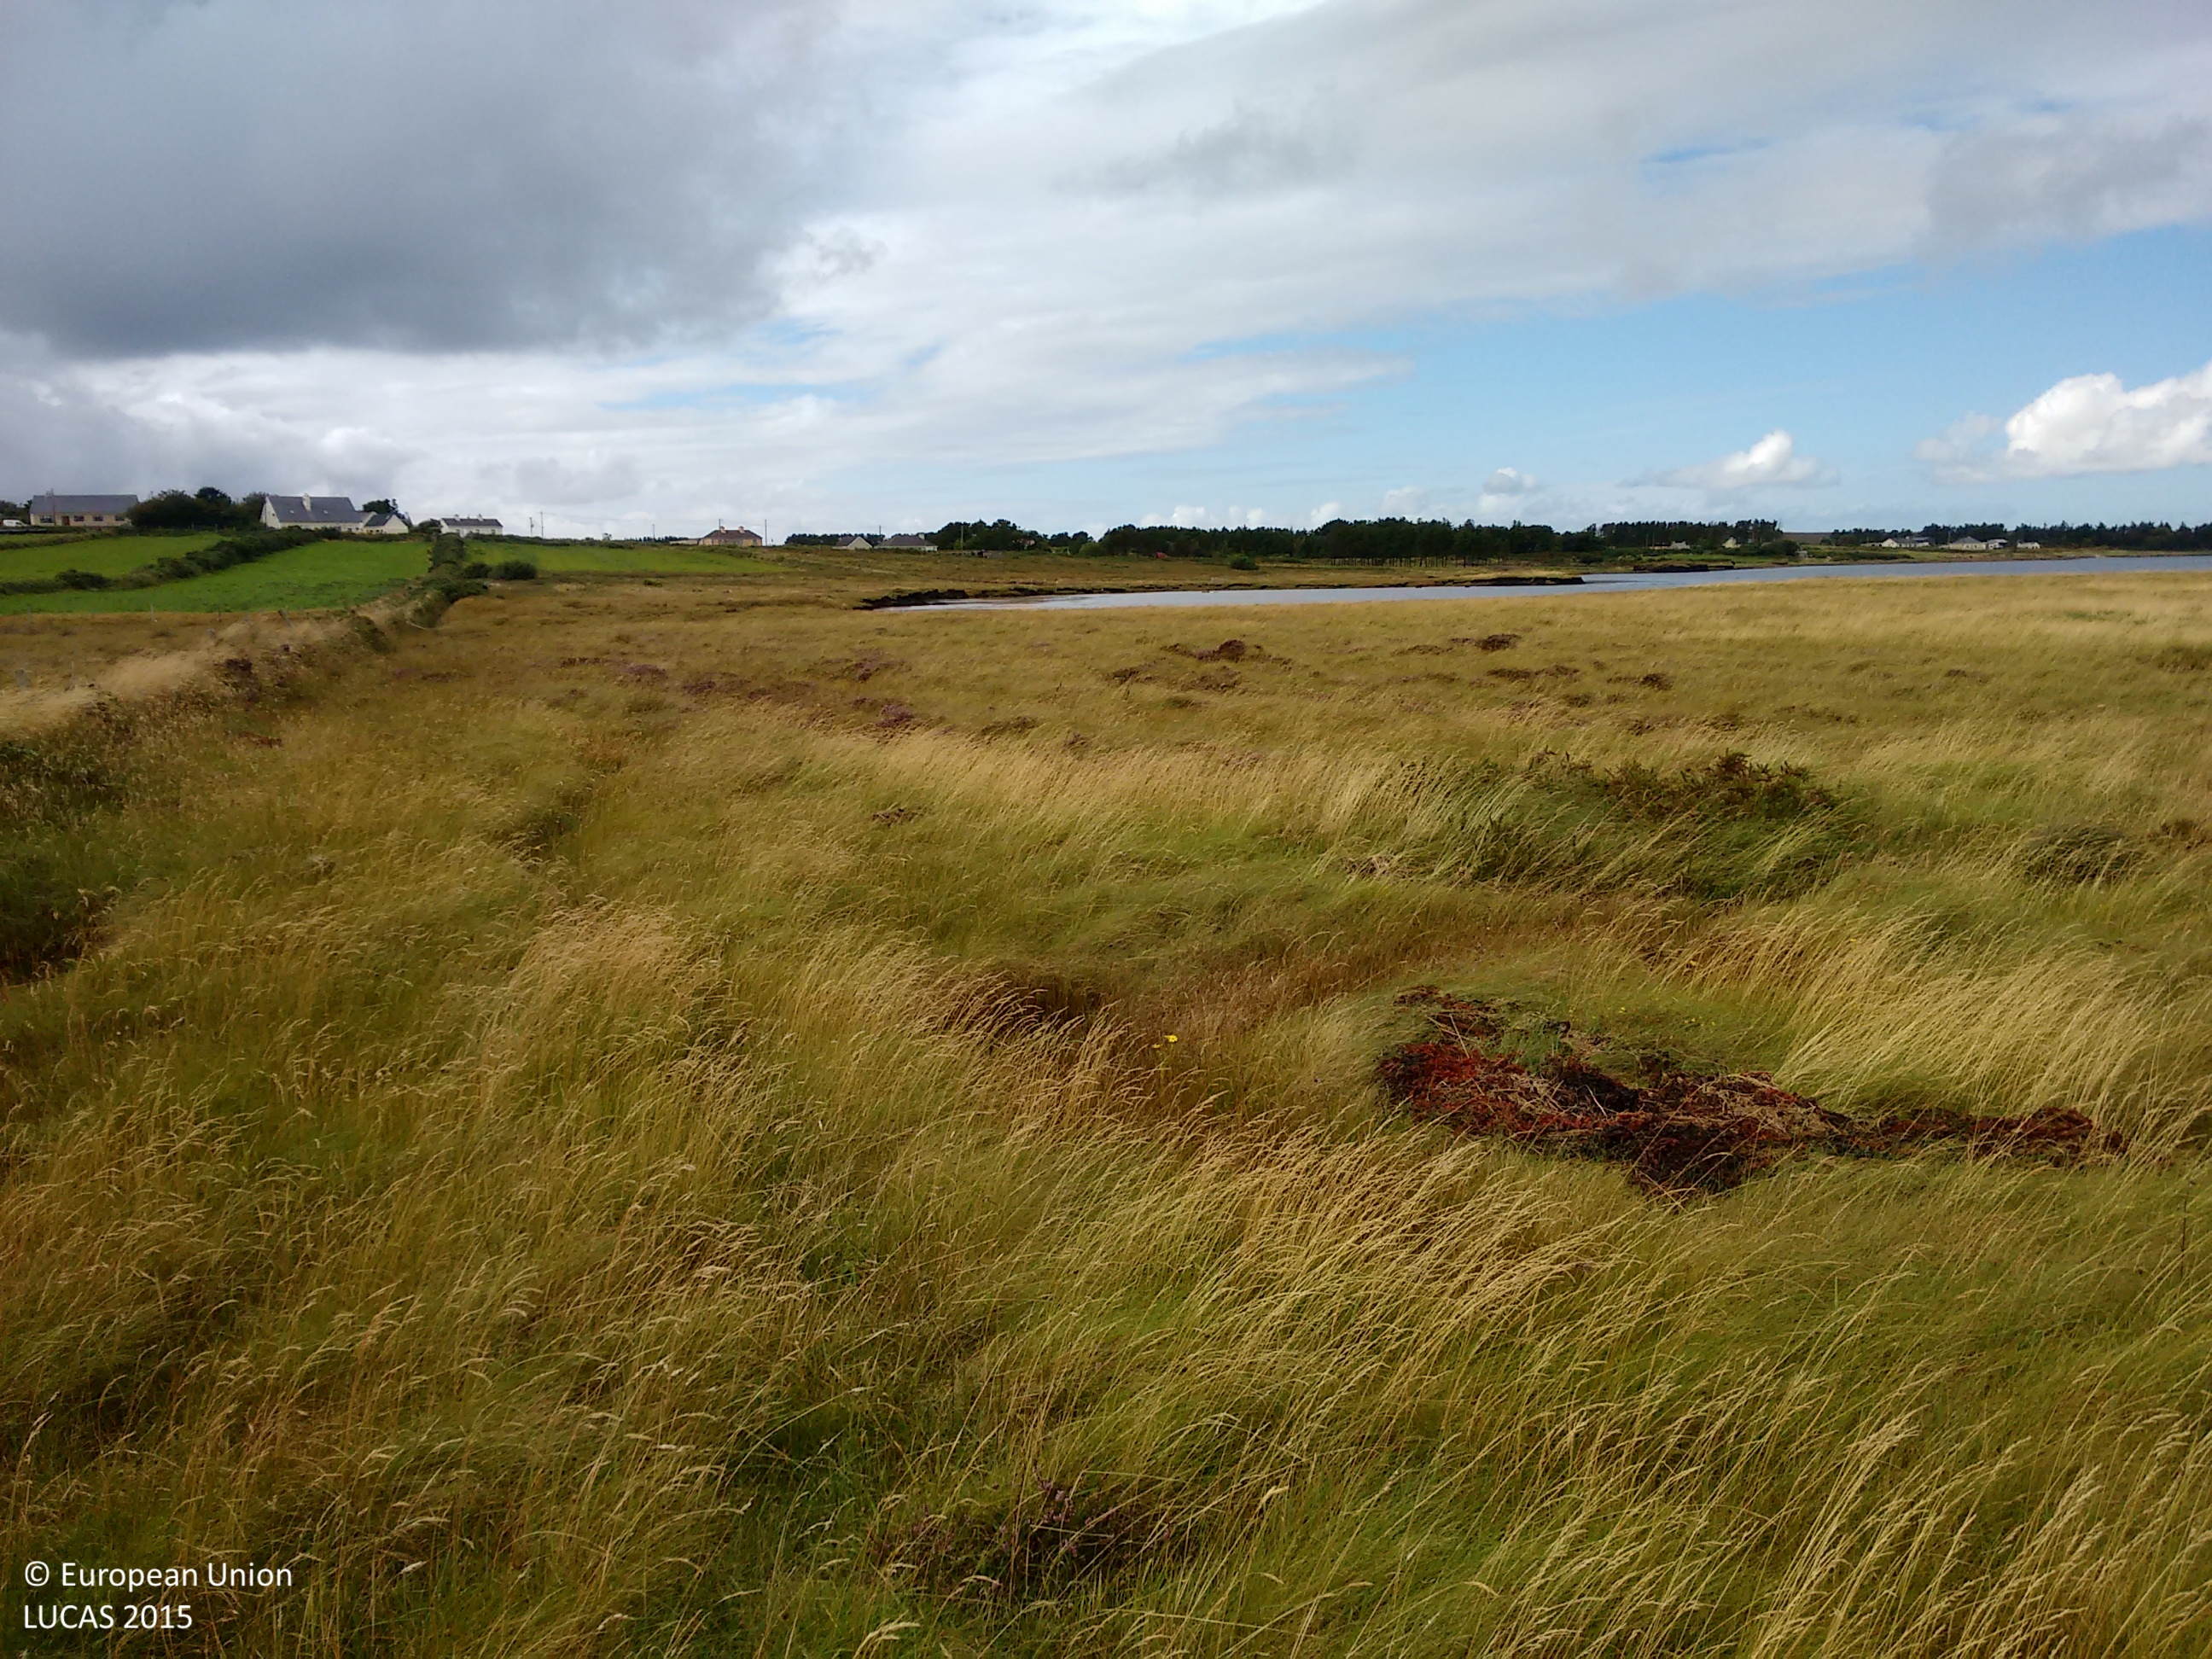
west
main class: Grassland
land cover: Grassland without tree/shrub cover
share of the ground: > 75 %
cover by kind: herbaceous plants 95 %
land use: Semi-natural and natural areas not in use
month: August
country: IE
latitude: 54.0840
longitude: -9.8913
